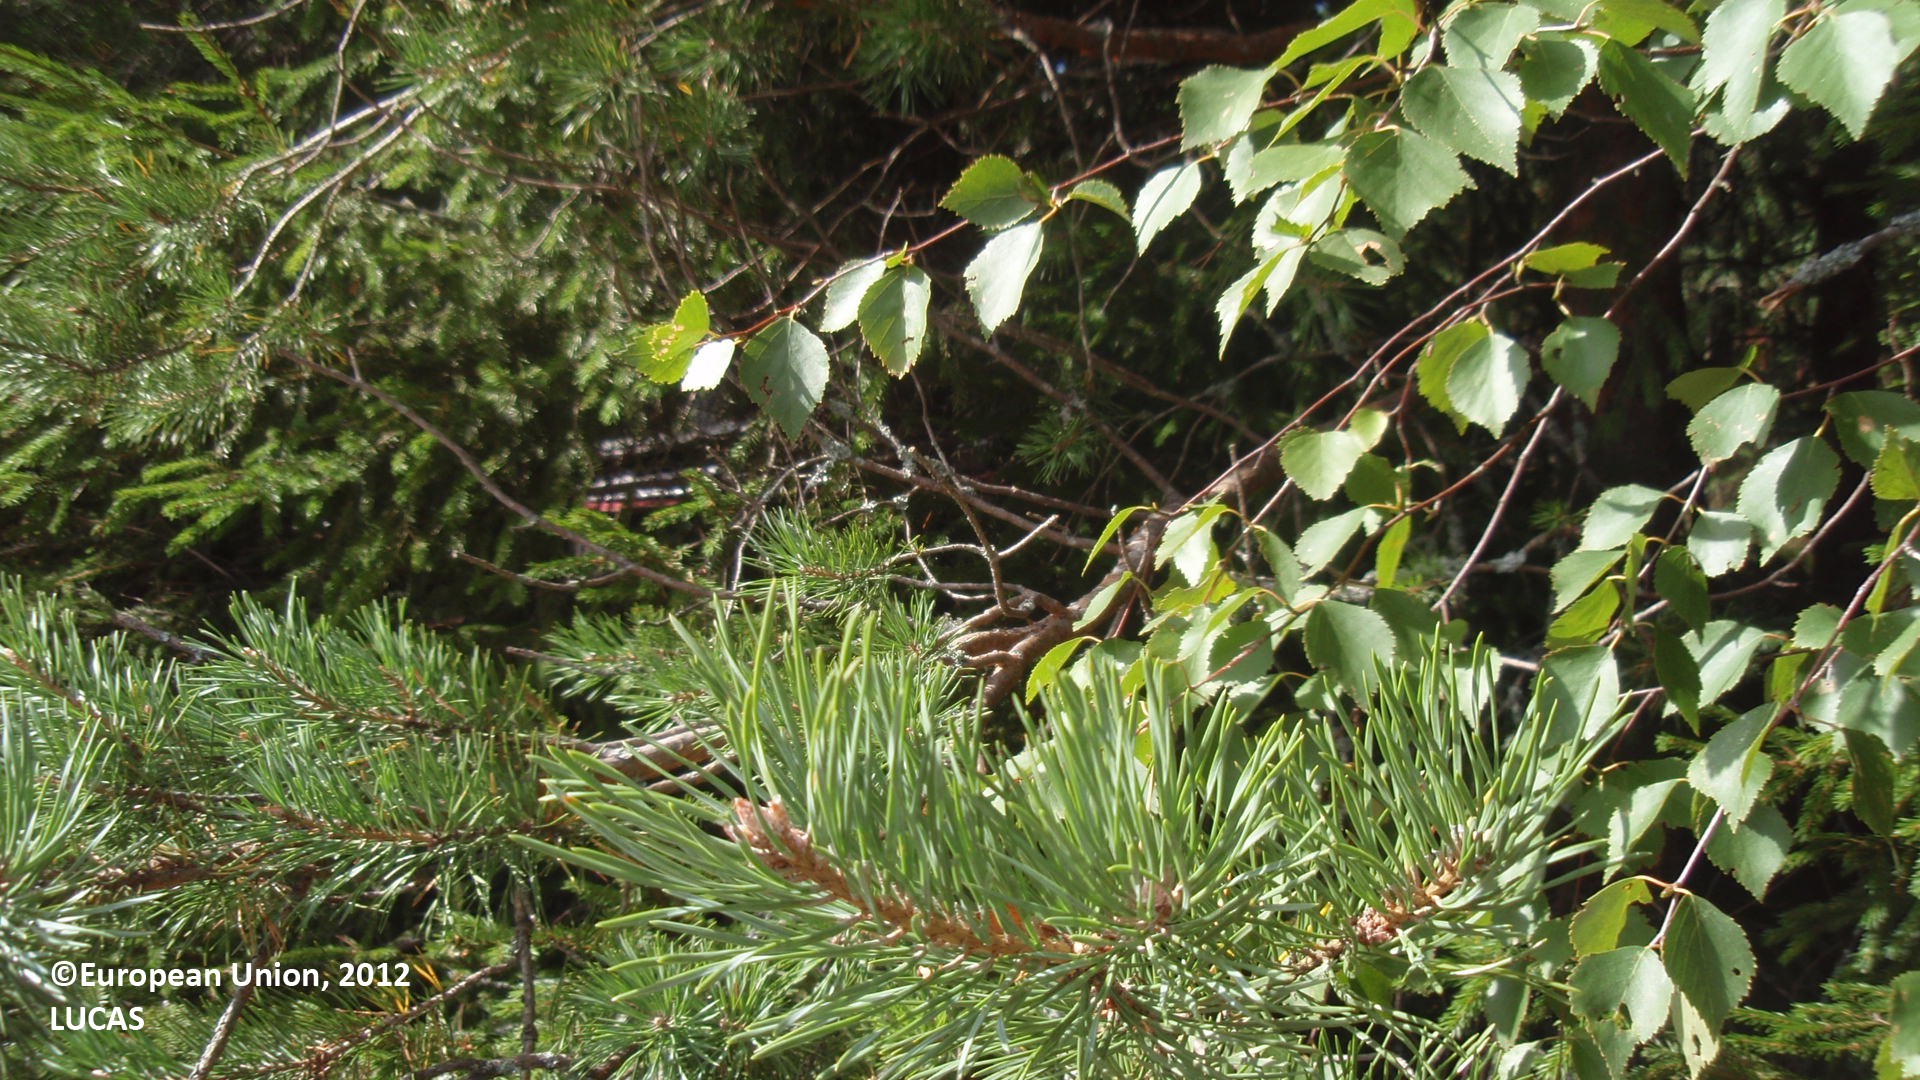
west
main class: Cropland
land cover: Barley
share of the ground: > 75 %
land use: Agriculture (excluding fallow land and kitchen gardens)
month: August
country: FI
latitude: 60.6551
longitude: 27.4334
